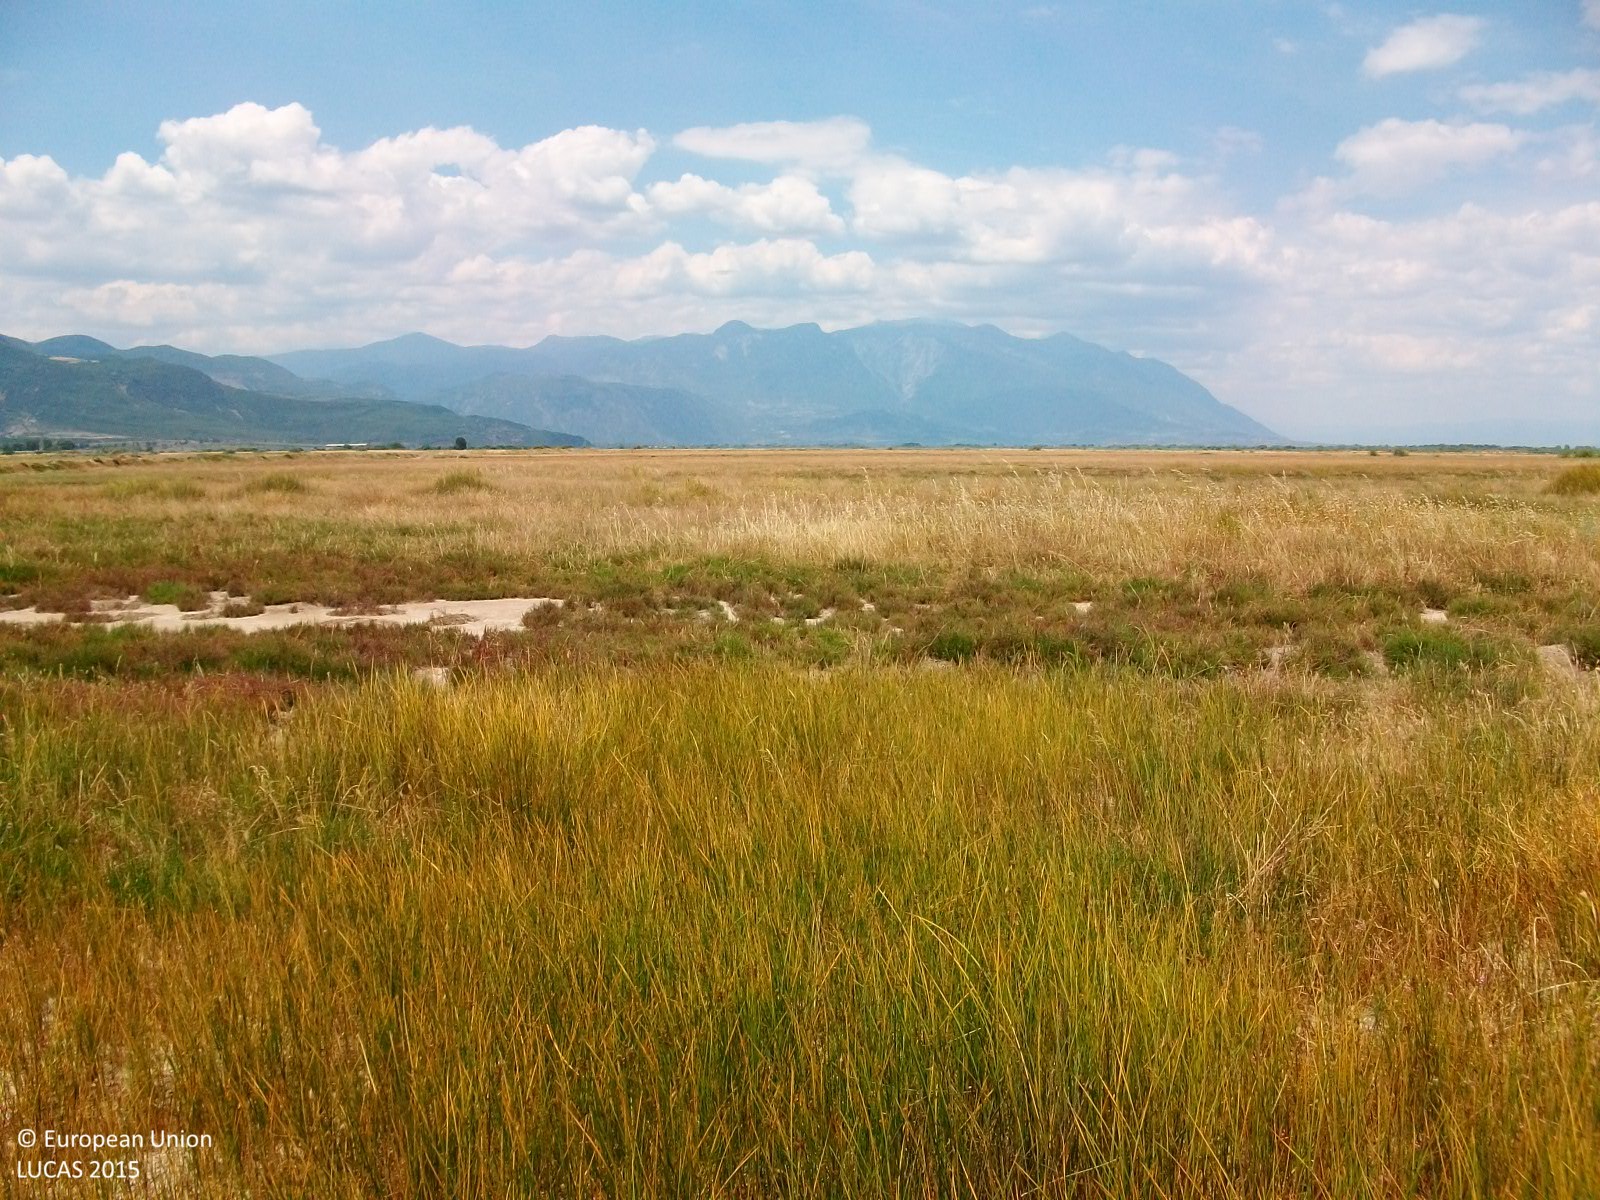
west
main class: Grassland
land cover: Spontaneously vegetated surfaces
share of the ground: > 75 %
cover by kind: herbaceous plants 100 %
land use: Fallow land
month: June
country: GR
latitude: 38.8152
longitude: 22.5686
